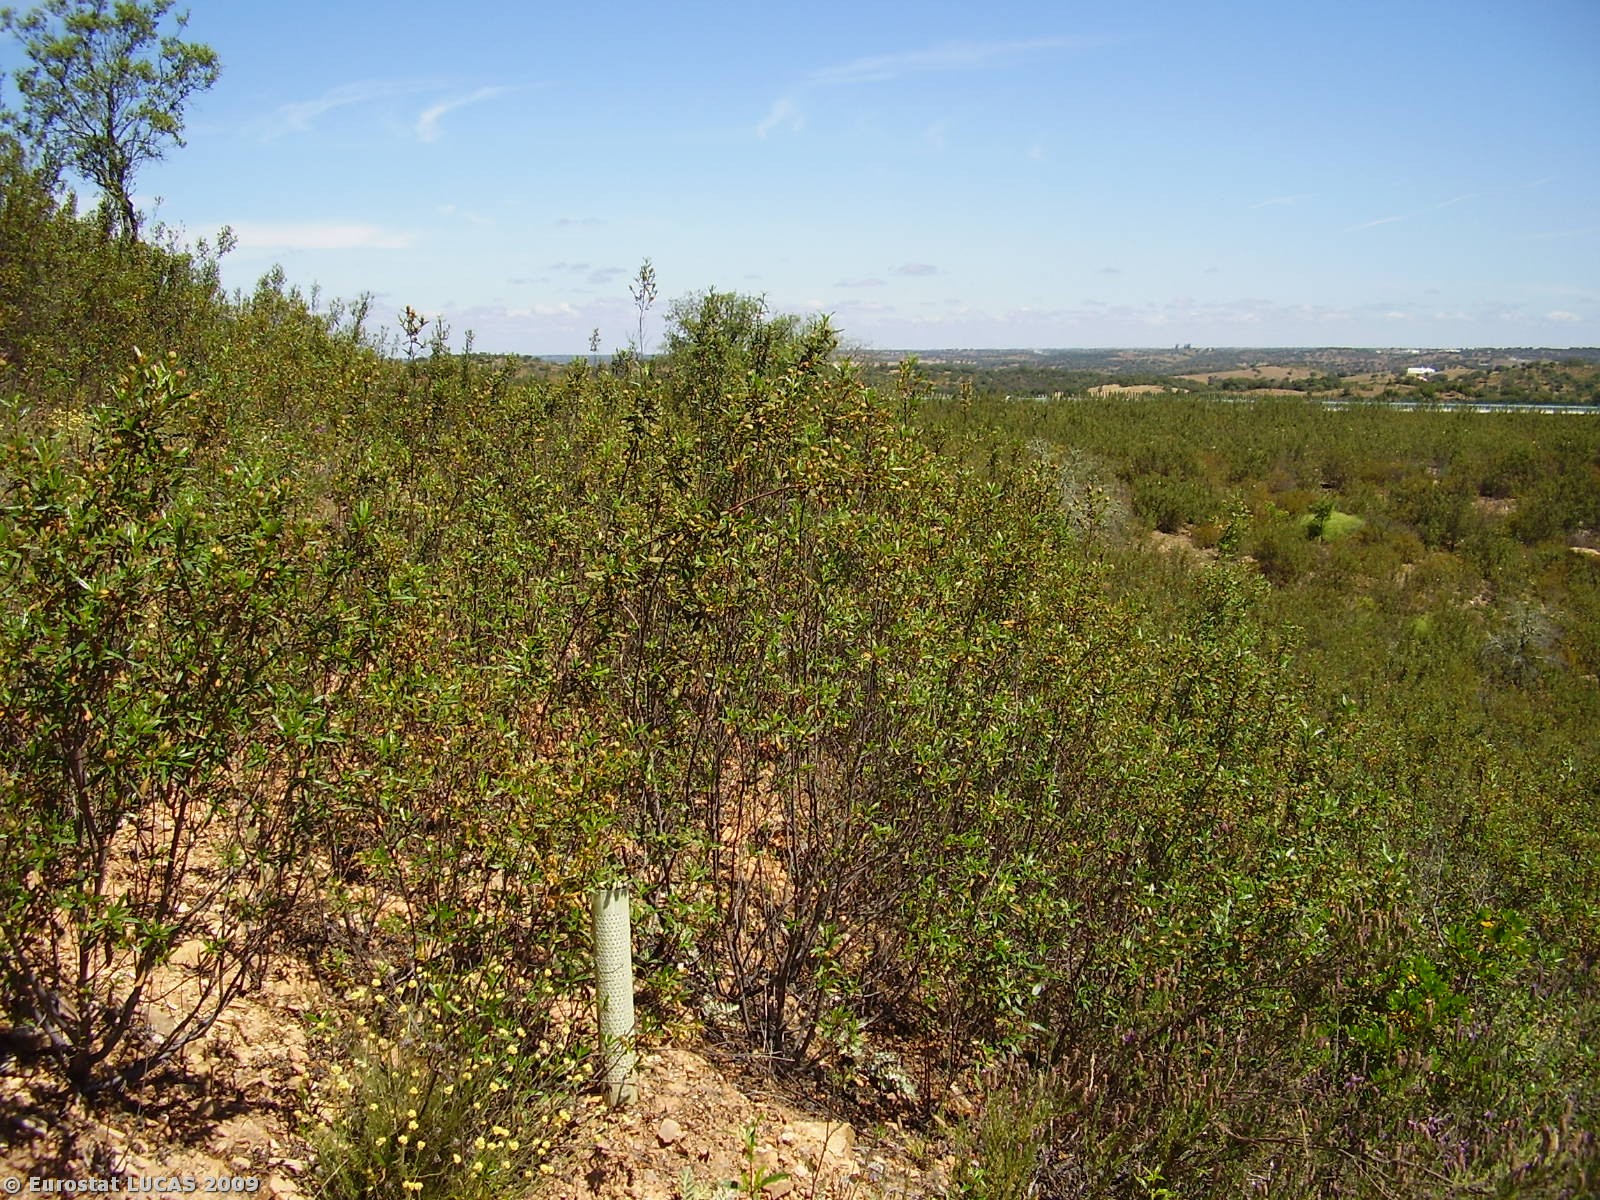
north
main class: Shrubland
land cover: Shrubland with sparse tree cover
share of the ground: > 75 %
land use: Fallow land
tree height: > 5 m
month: May
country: PT
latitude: 37.4938
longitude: -8.2011
